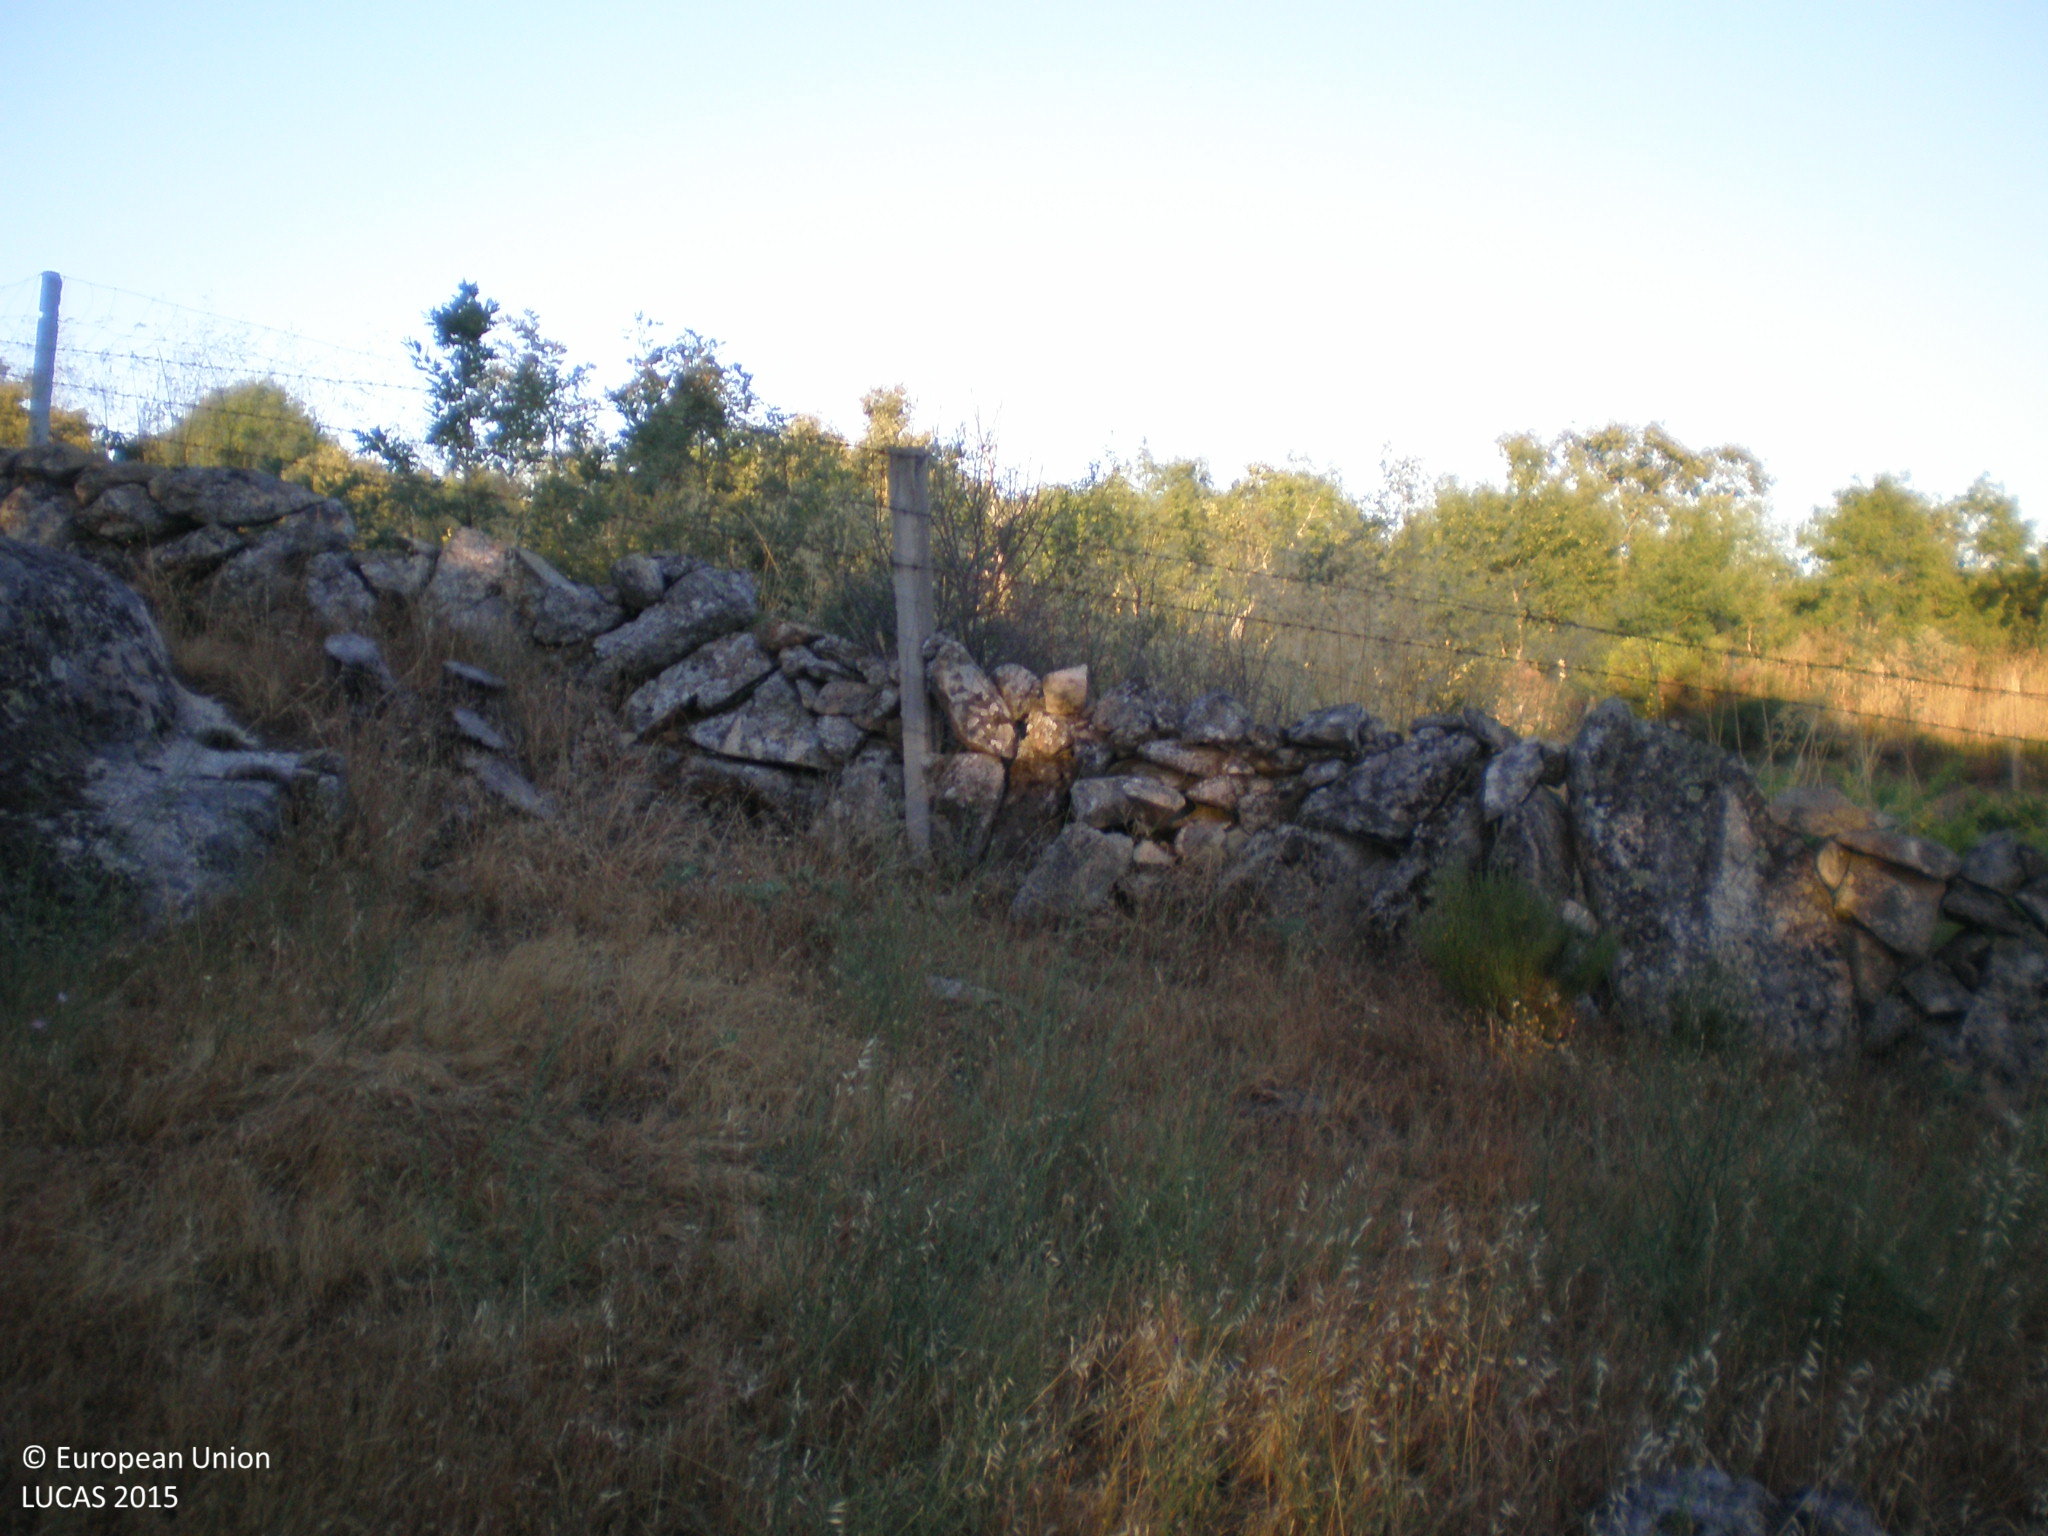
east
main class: Grassland
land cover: Grassland with sparse tree/shrub cover
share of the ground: > 75 %
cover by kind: herbaceous plants 95 %, broadleaved forest trees 5 %
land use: Agriculture (excluding fallow land and kitchen gardens)
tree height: < 5 m
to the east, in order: Grassland with sparse tree/shrub cover; Dry stone walls; Vineyards; Dry stone walls; Grassland with sparse tree/shrub cover; Dry stone walls; Grassland with sparse tree/shrub cover; Dry stone walls; Grassland with sparse tree/shrub cover; Dry stone walls; Grassland with sparse tree/shrub cover
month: June
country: ES
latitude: 40.5391
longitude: -5.8121
